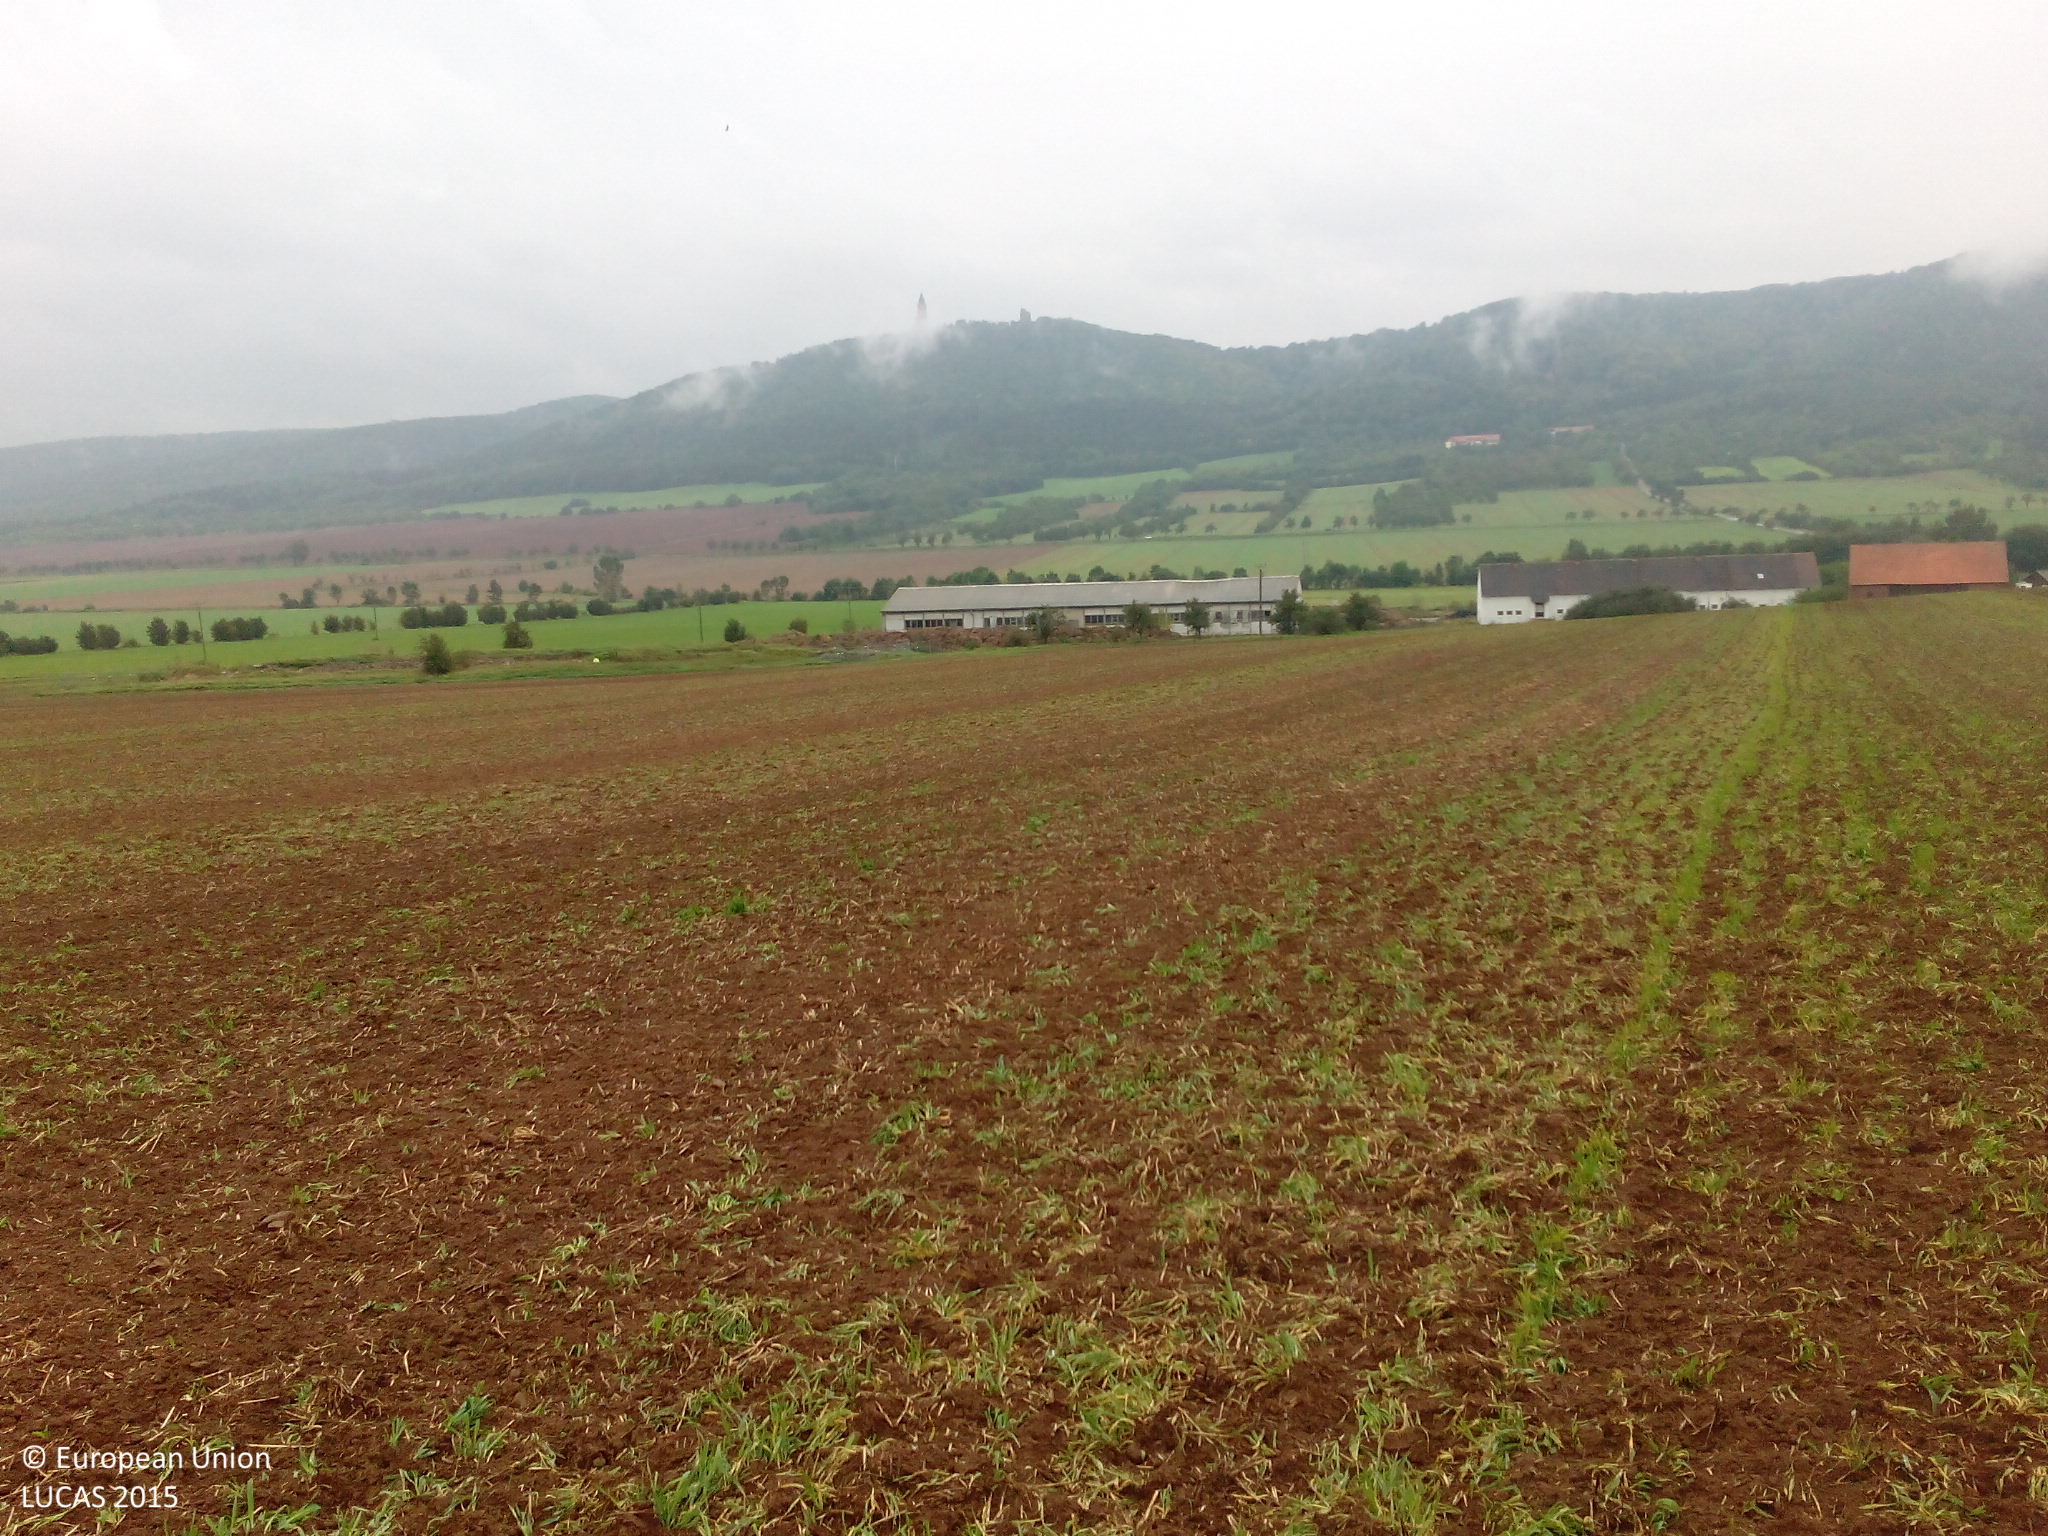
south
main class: Cropland
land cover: Barley
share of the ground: 10 - 25 %
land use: Agriculture (excluding fallow land and kitchen gardens)
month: September
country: DE
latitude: 51.4375
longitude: 11.1074
